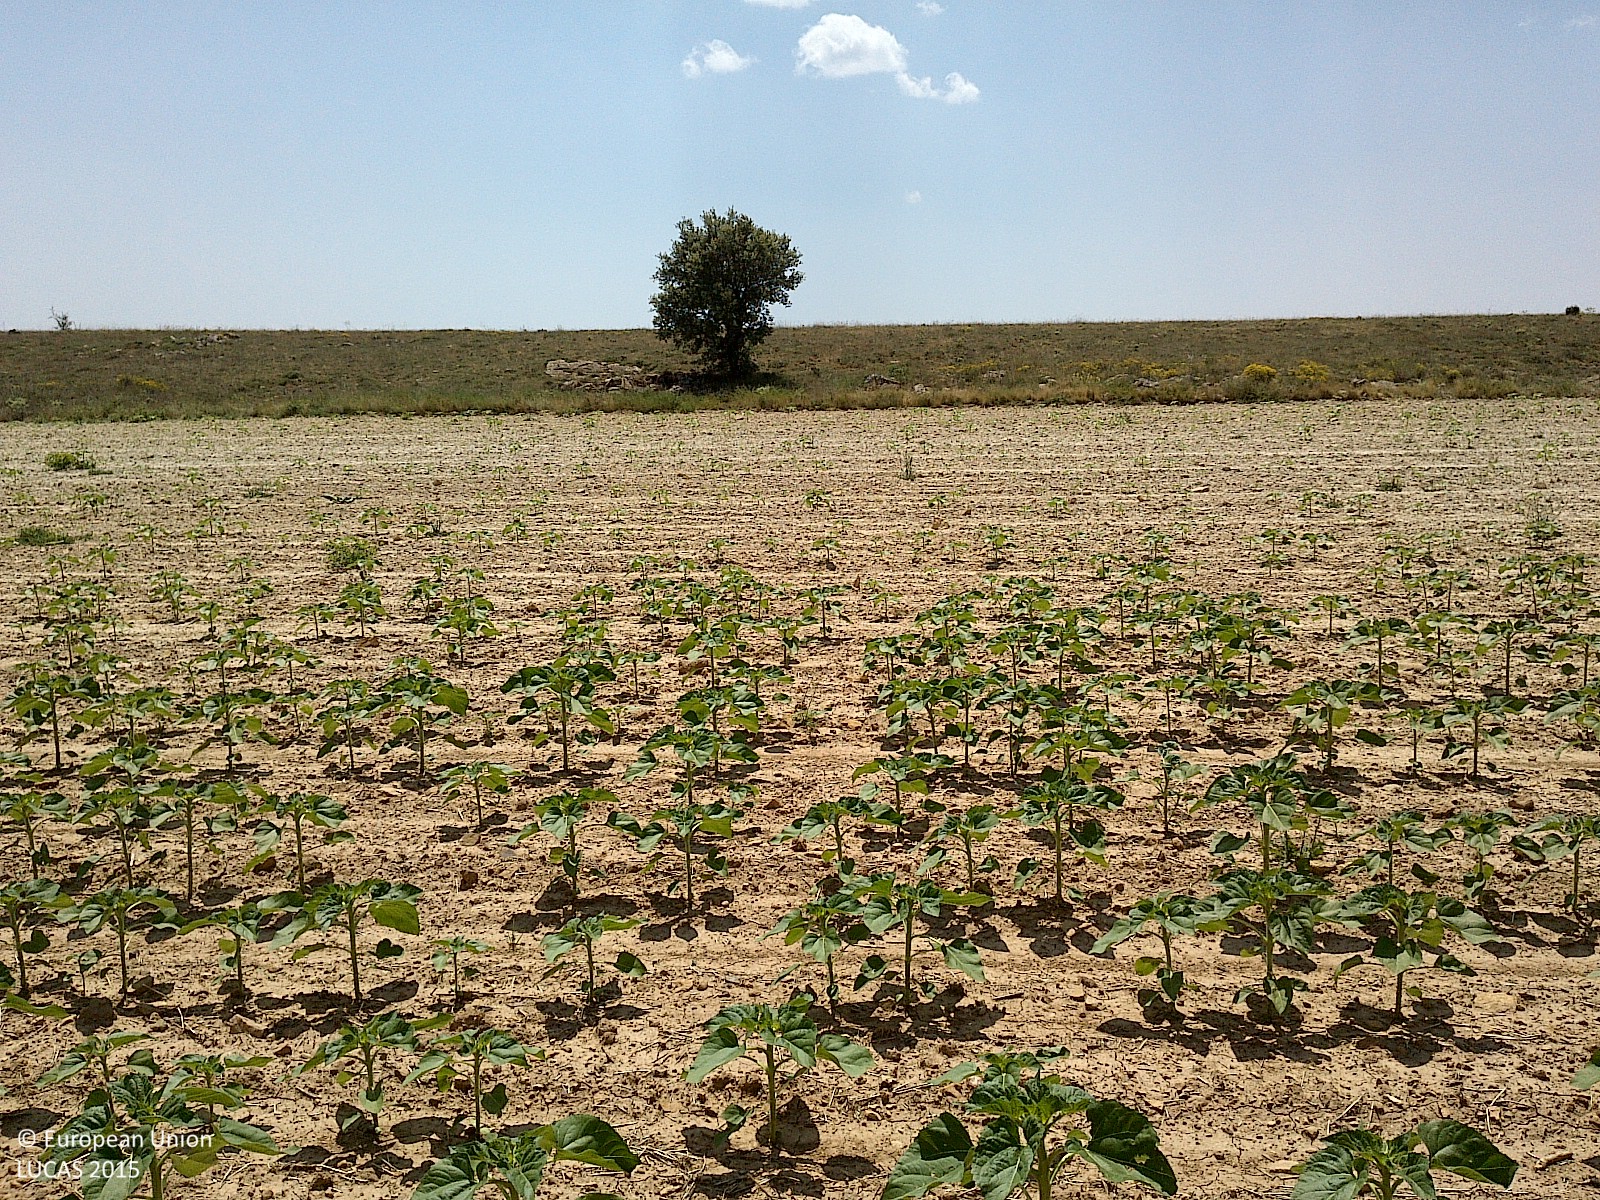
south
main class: Cropland
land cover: Sunflower
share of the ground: 10 - 25 %
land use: Agriculture (excluding fallow land and kitchen gardens)
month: July
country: ES
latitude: 41.5894
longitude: -2.0153
